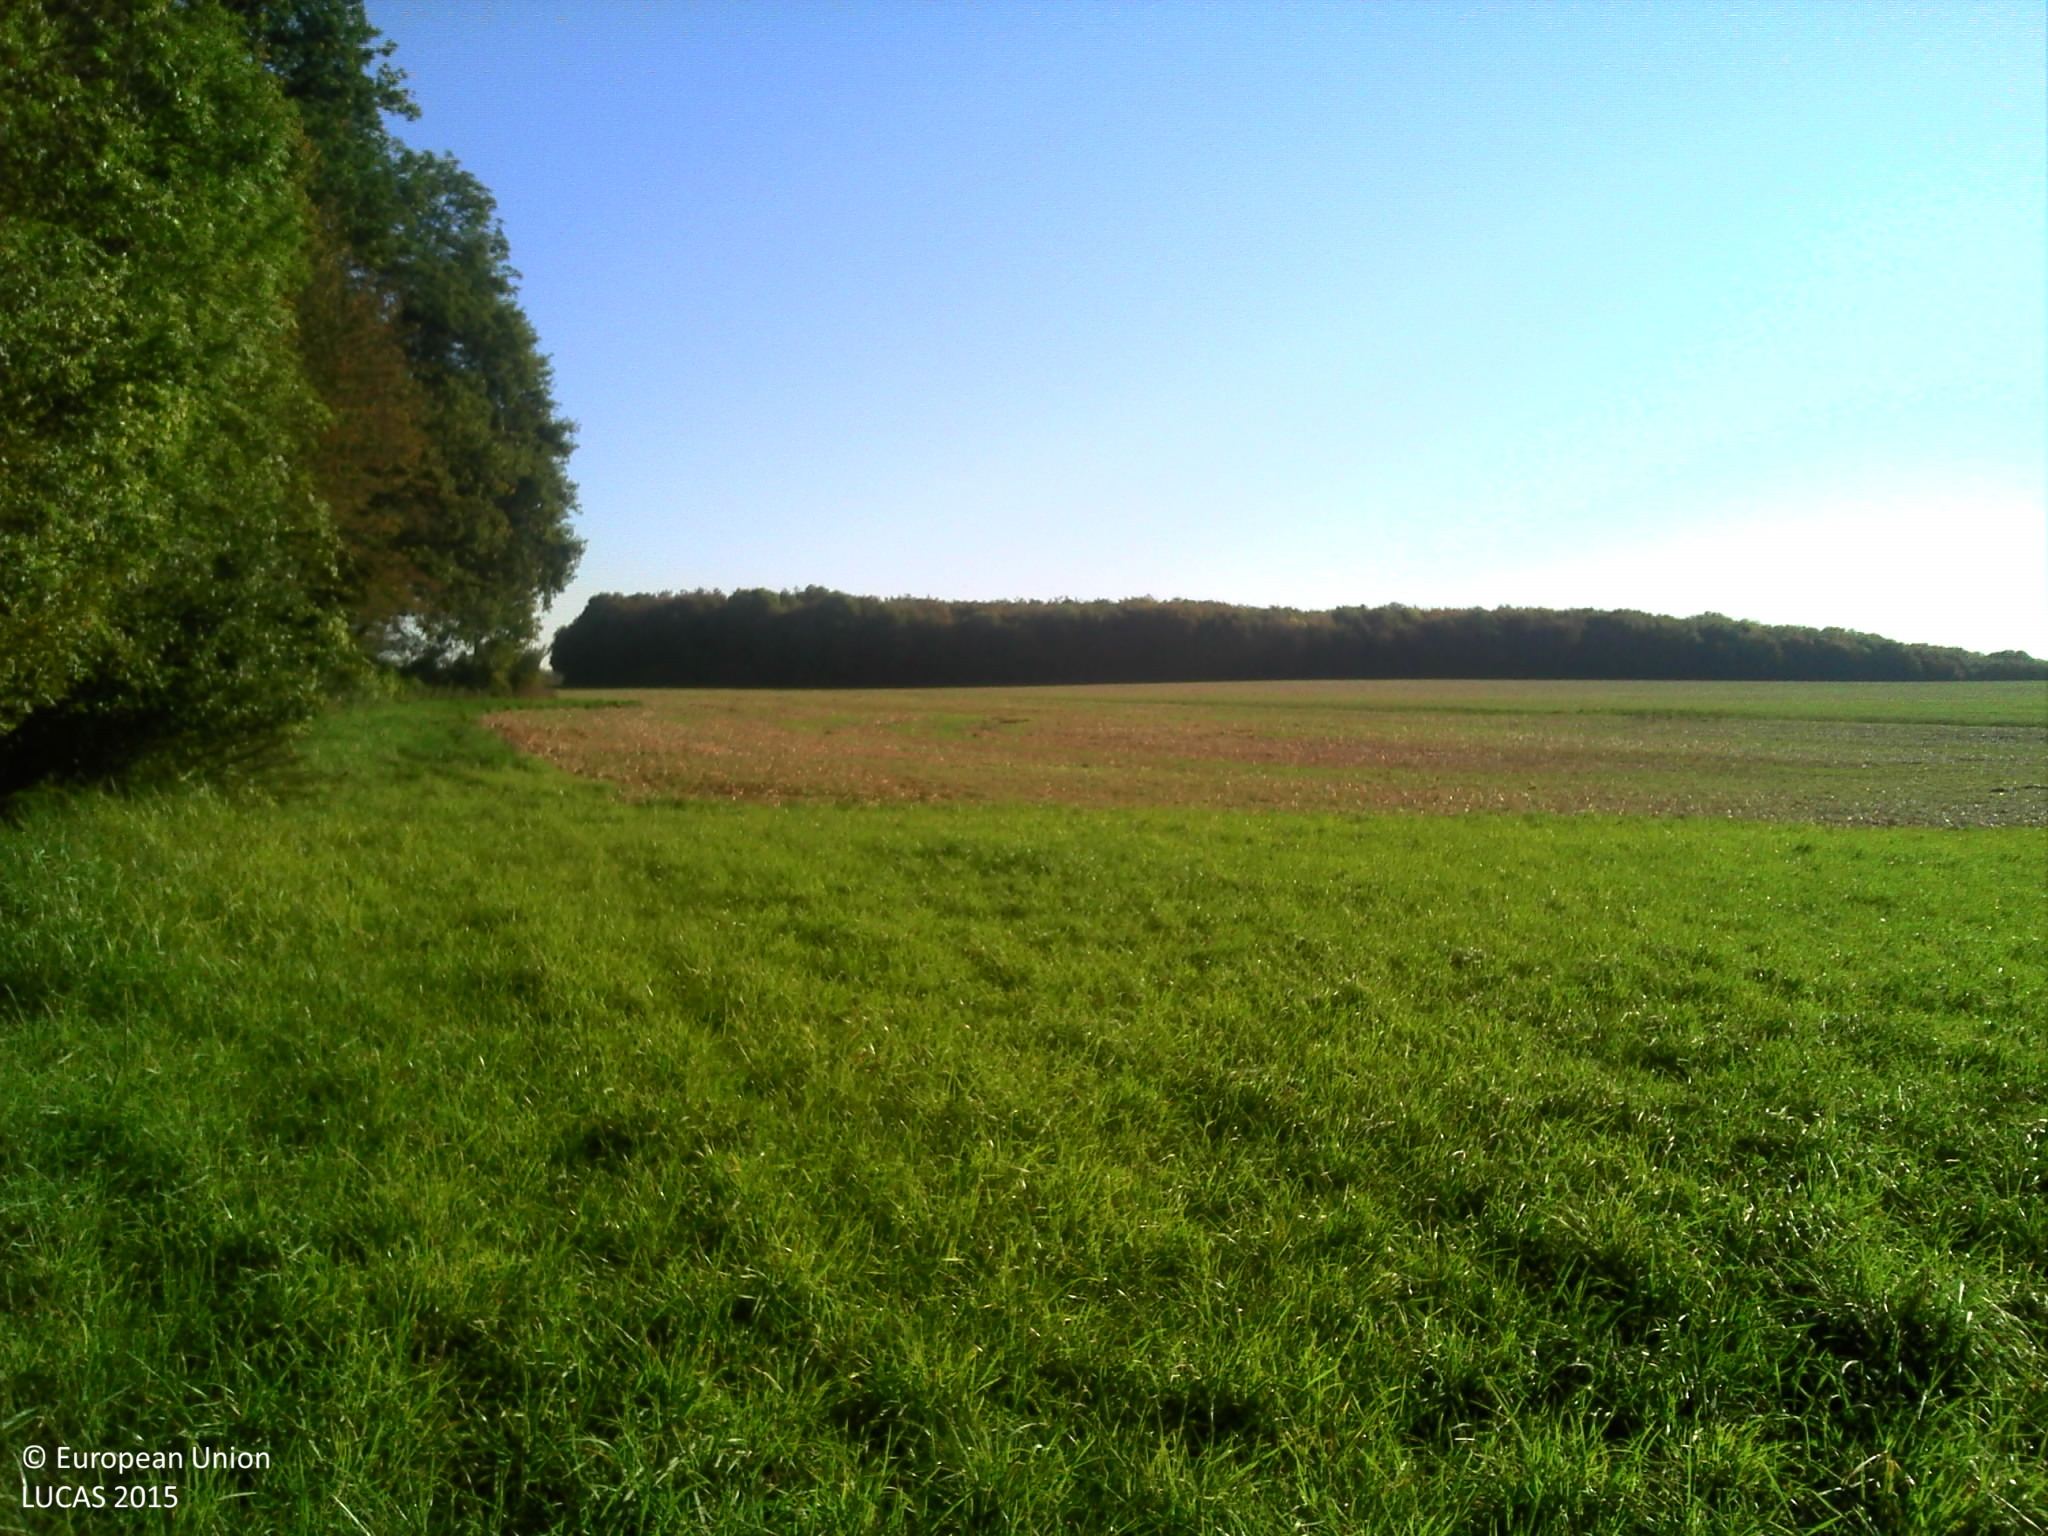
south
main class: Cropland
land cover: Temporary grasslands
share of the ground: > 75 %
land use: Agriculture (excluding fallow land and kitchen gardens)
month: October
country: FR
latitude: 49.1411
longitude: 5.9831
